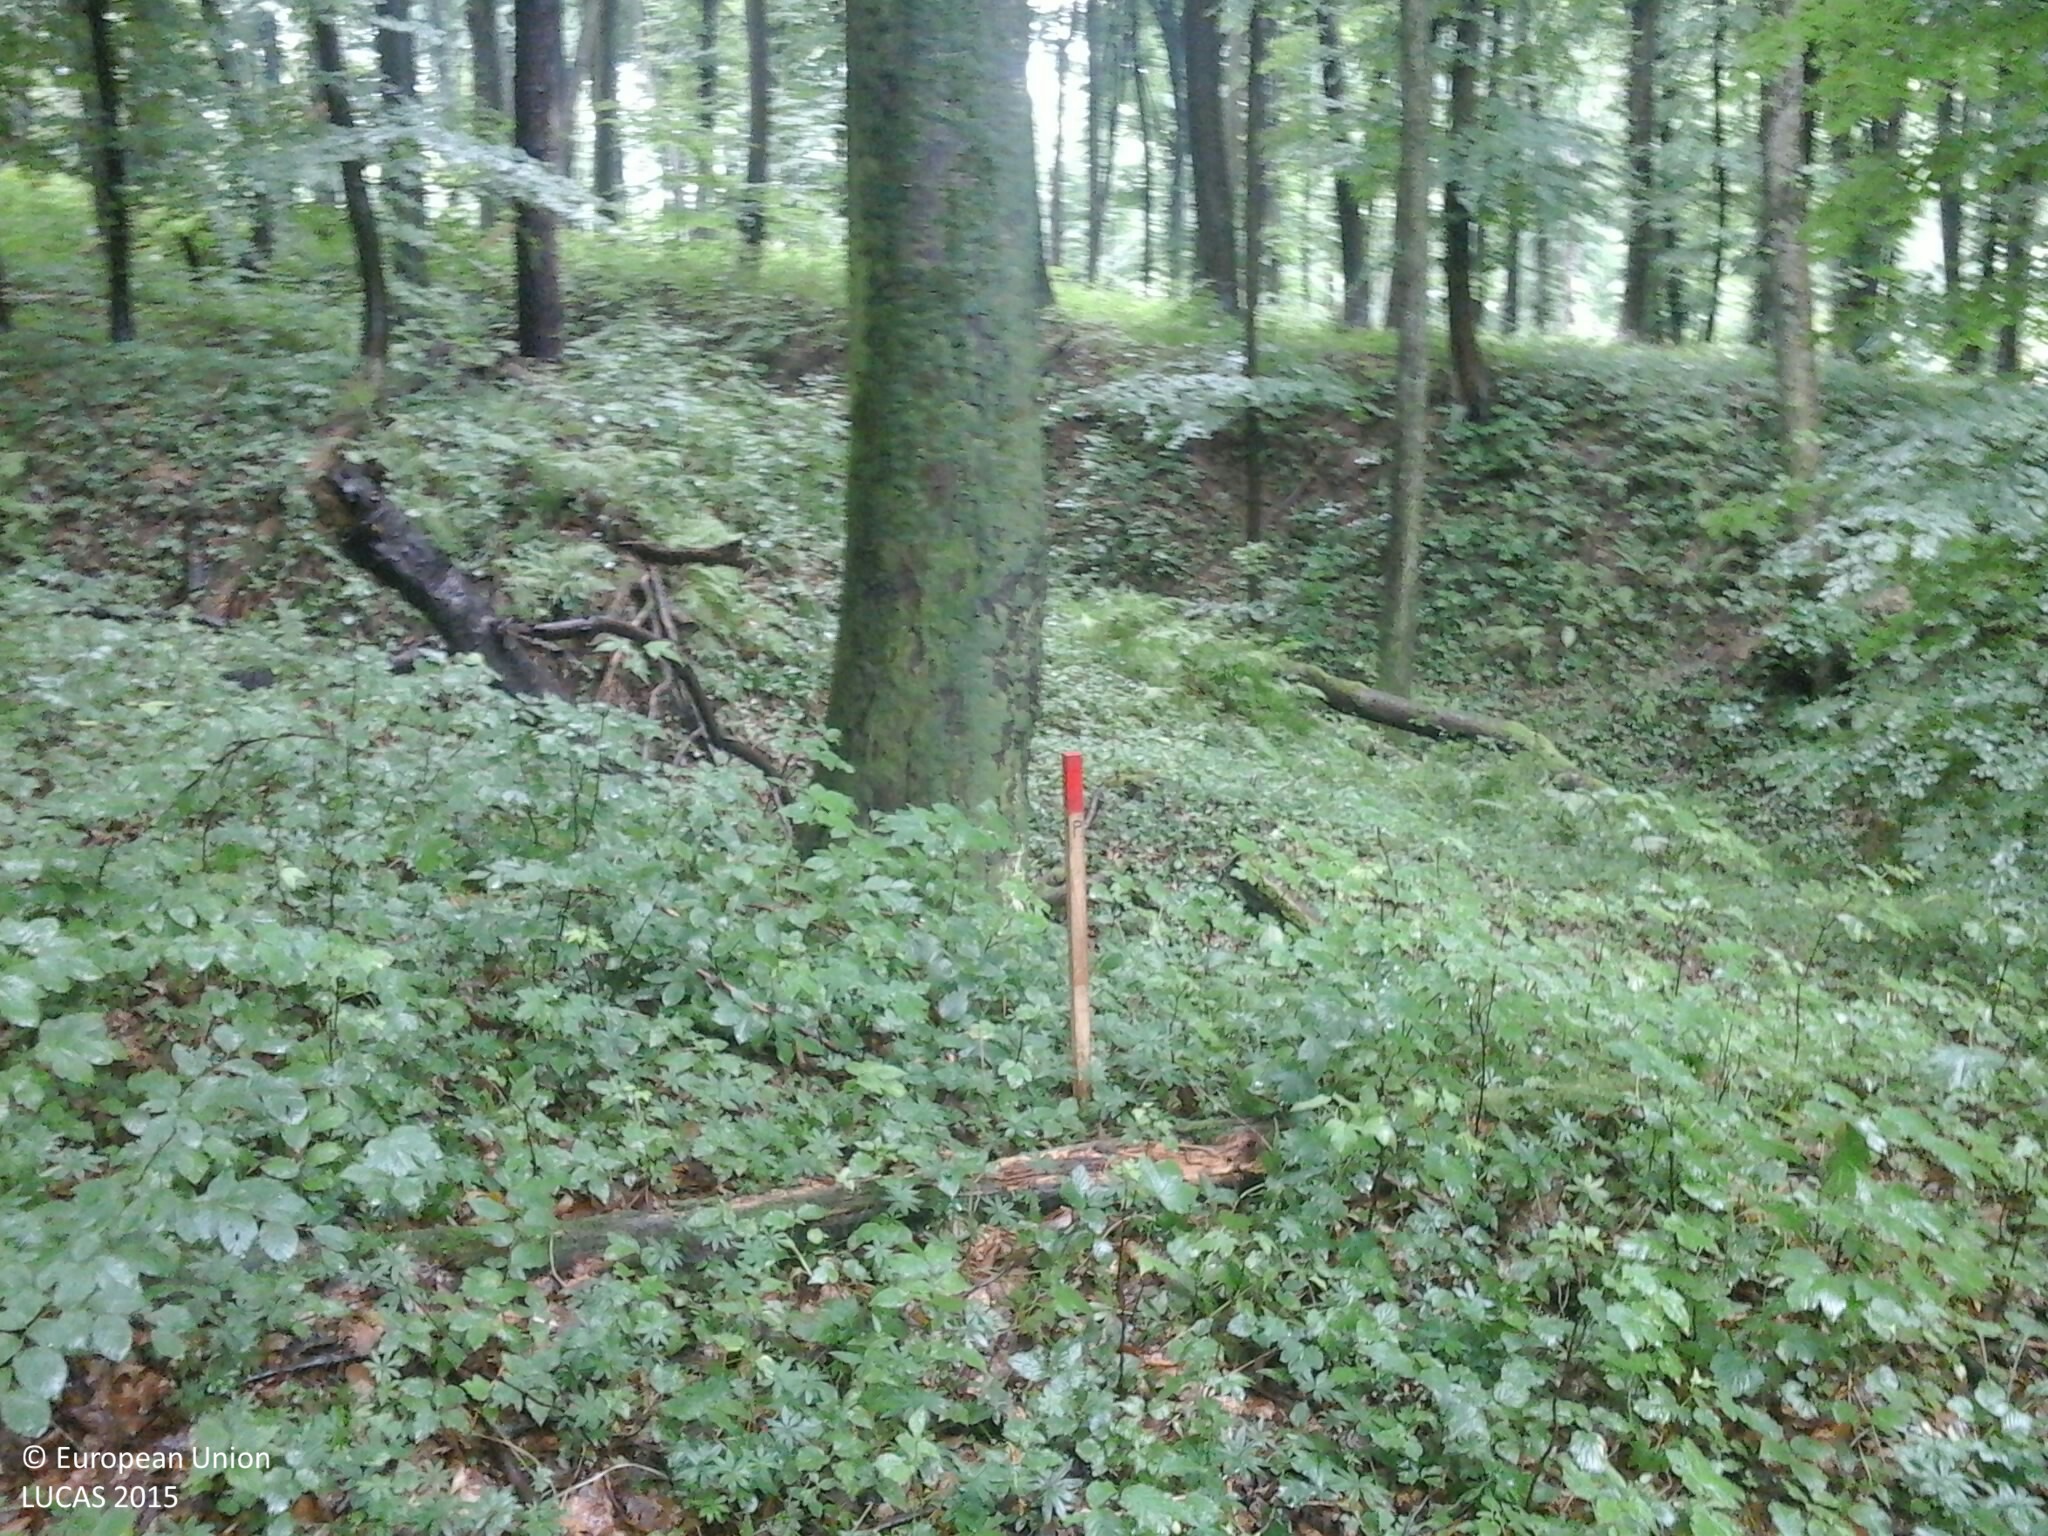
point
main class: Woodland
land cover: Broadleaved woodland
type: beech forest
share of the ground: > 75 %
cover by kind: broadleaved forest trees 80 %, shrubs 10 %, herbaceous plants 10 %
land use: Forestry
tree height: > 5 m
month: July
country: HU
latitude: 46.5862
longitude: 16.5138
